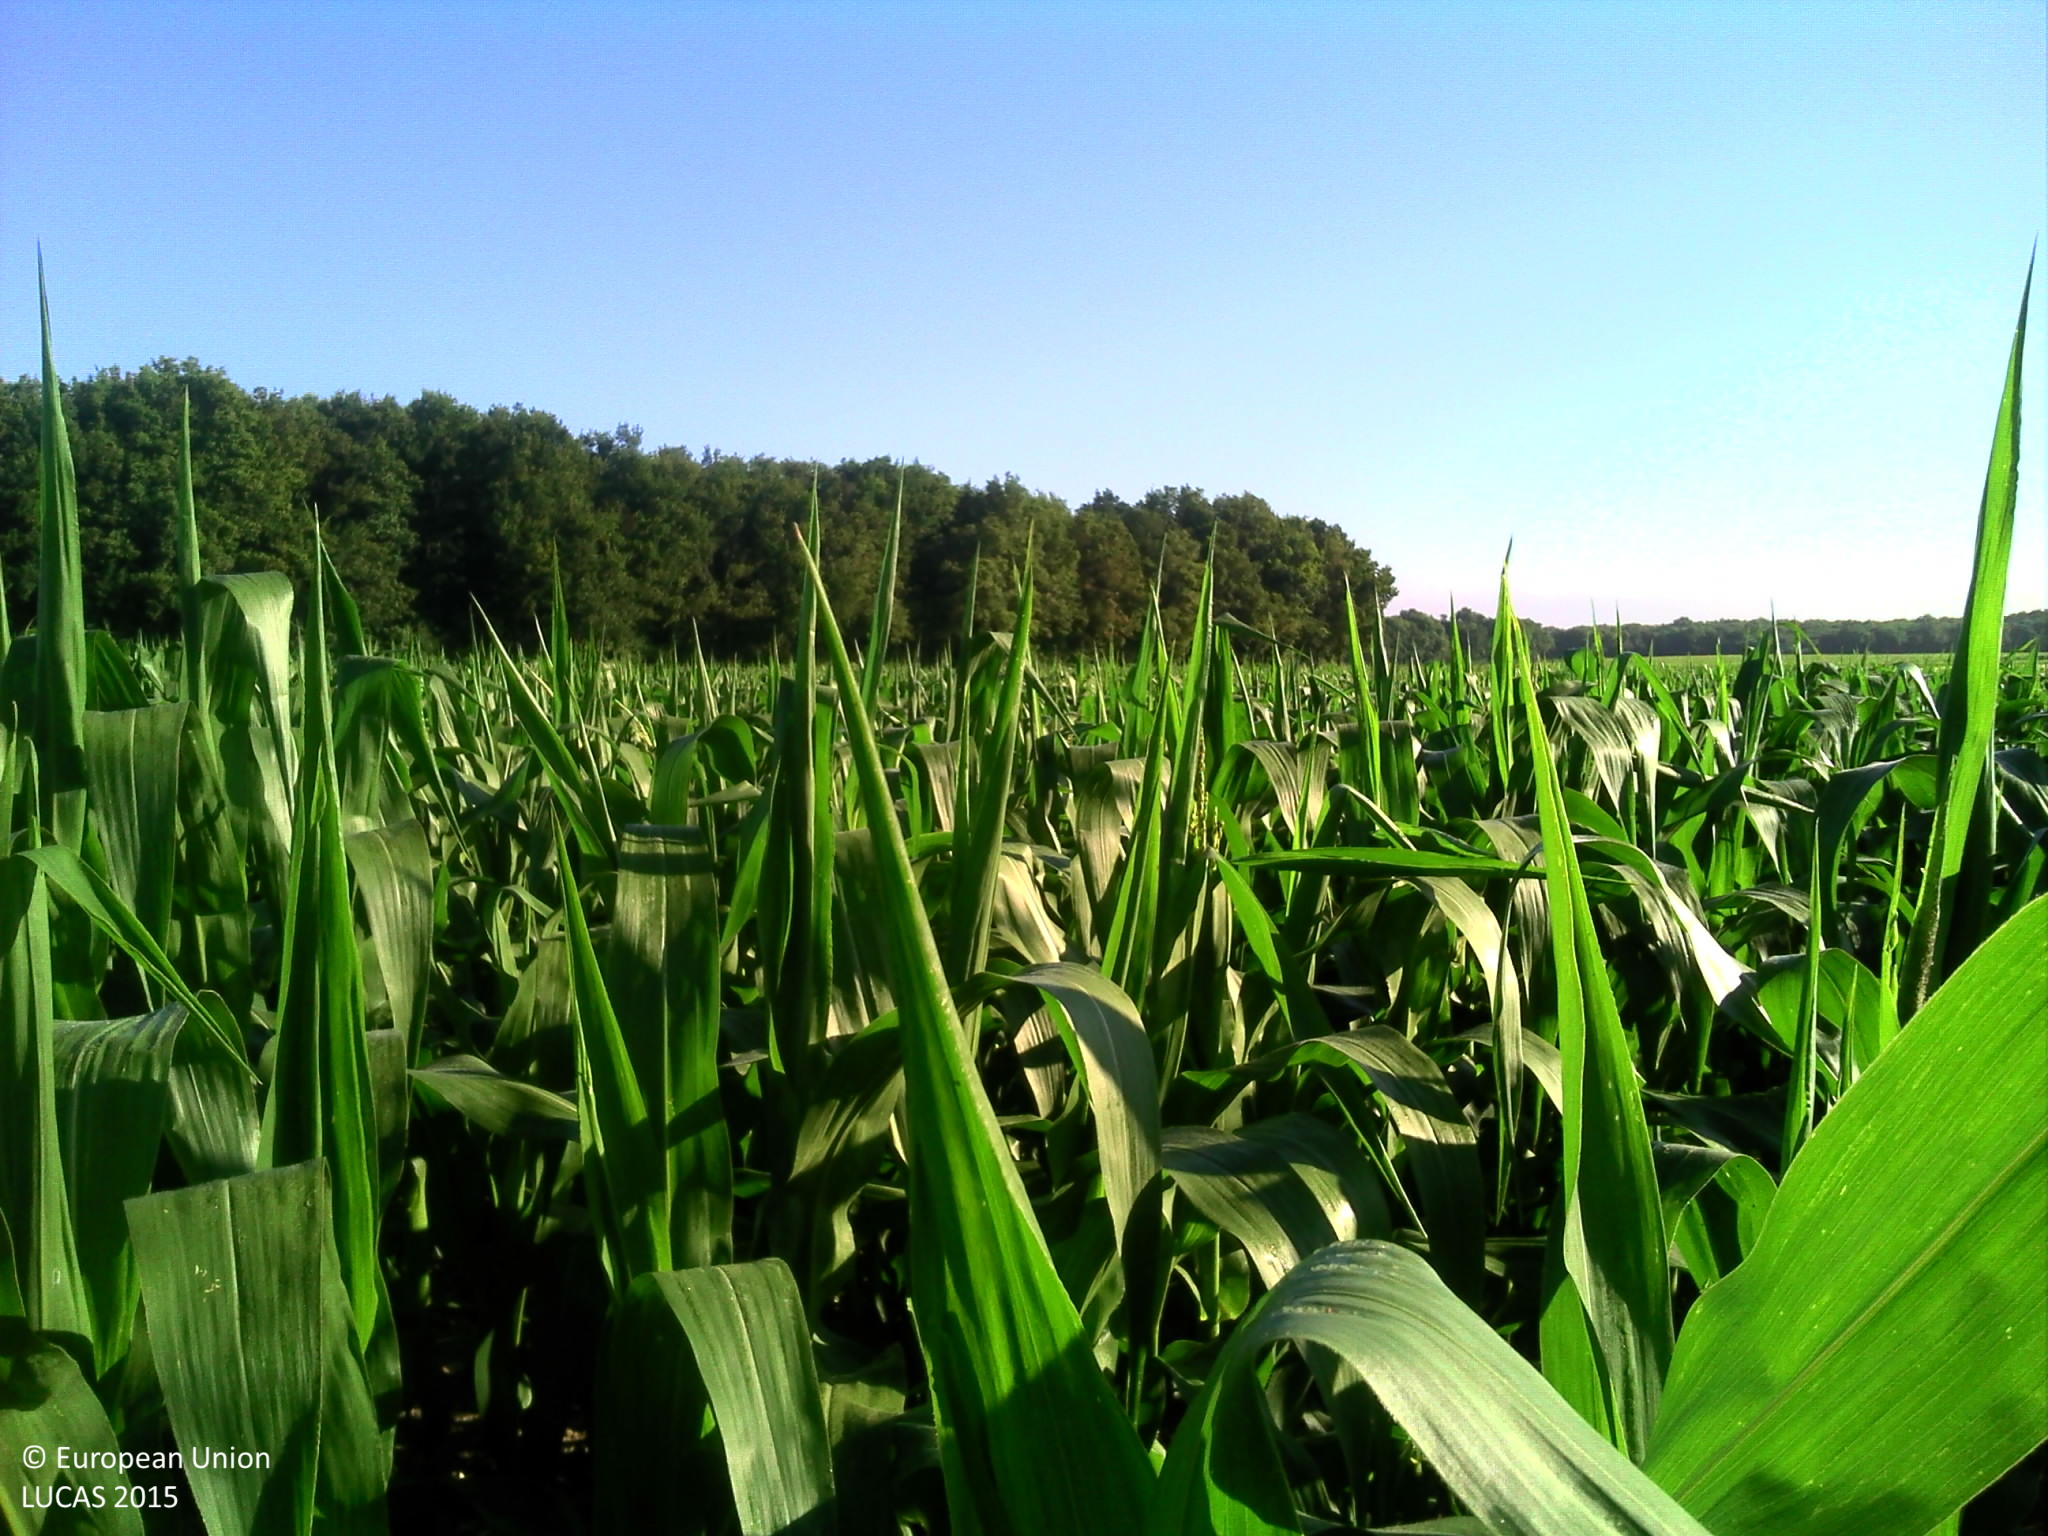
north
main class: Cropland
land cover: Maize
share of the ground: > 75 %
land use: Agriculture (excluding fallow land and kitchen gardens)
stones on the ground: 25 - 50 %
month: June
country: FR
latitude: 45.6325
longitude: -0.8654
